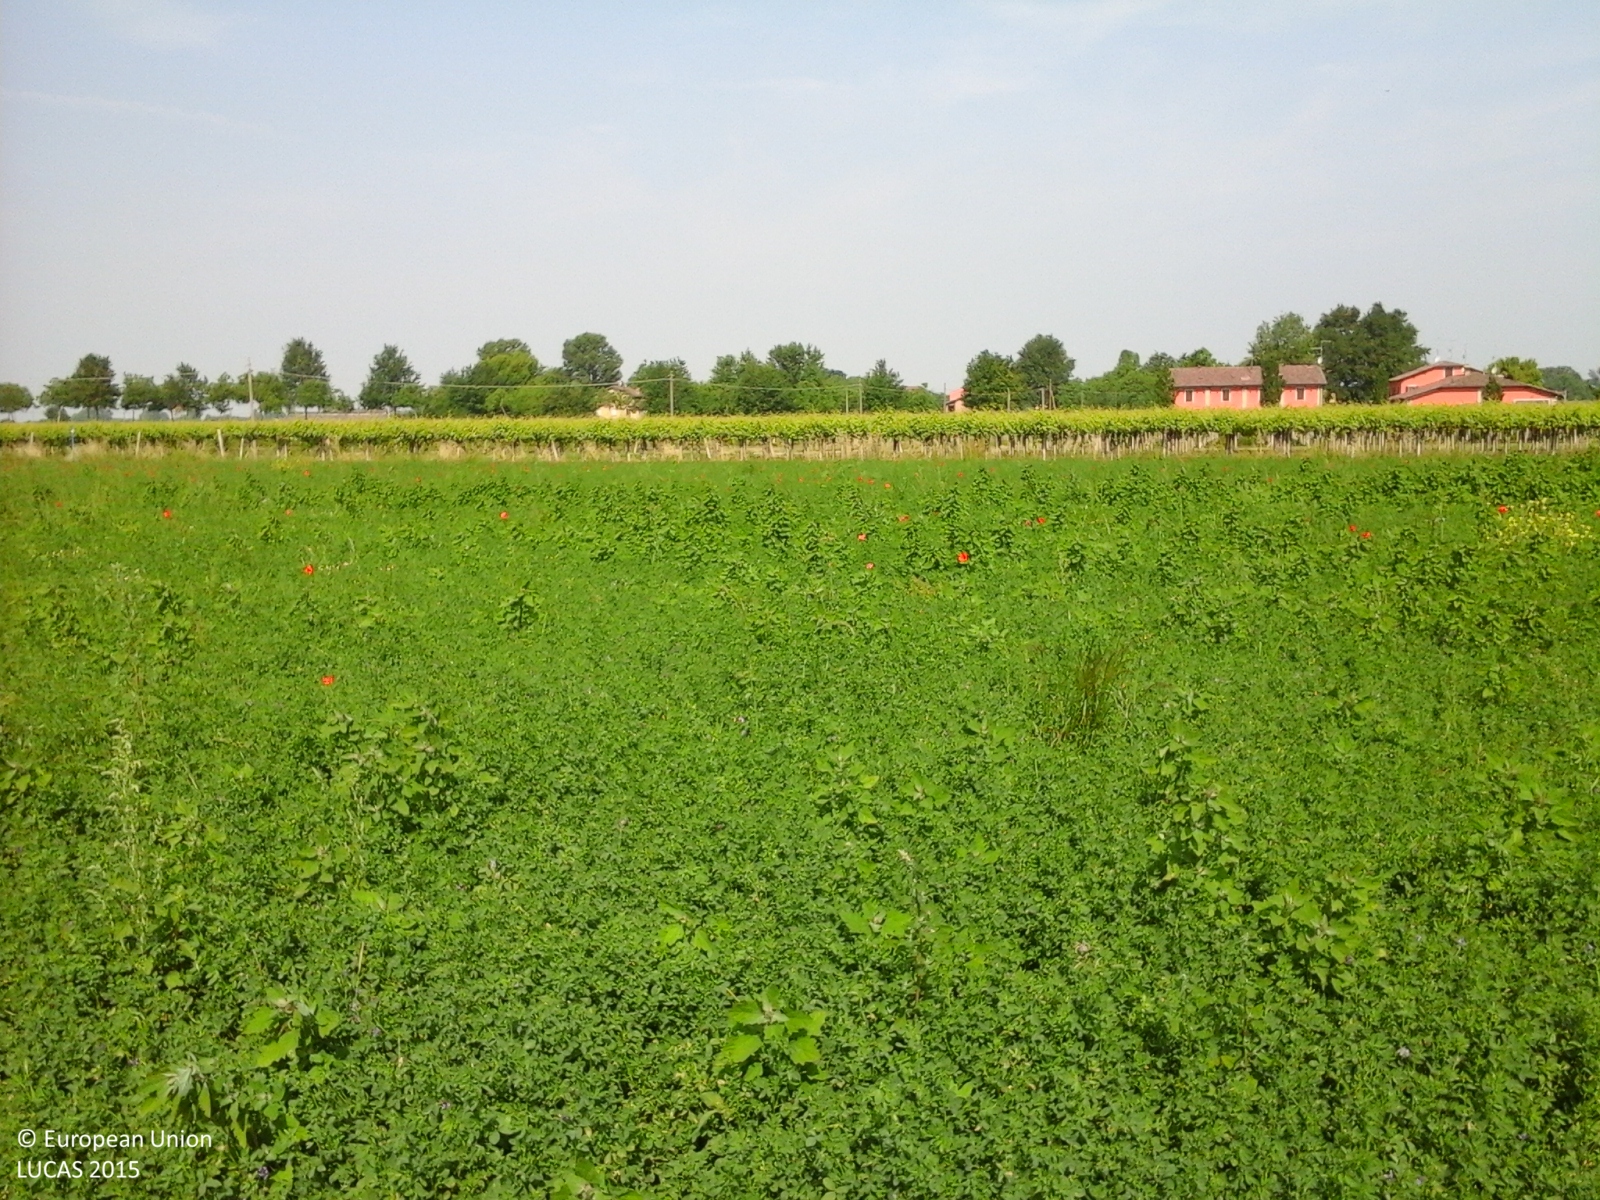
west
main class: Cropland
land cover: Lucerne
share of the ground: > 75 %
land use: Agriculture (excluding fallow land and kitchen gardens)
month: May
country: IT
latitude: 44.7082
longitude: 10.7935
